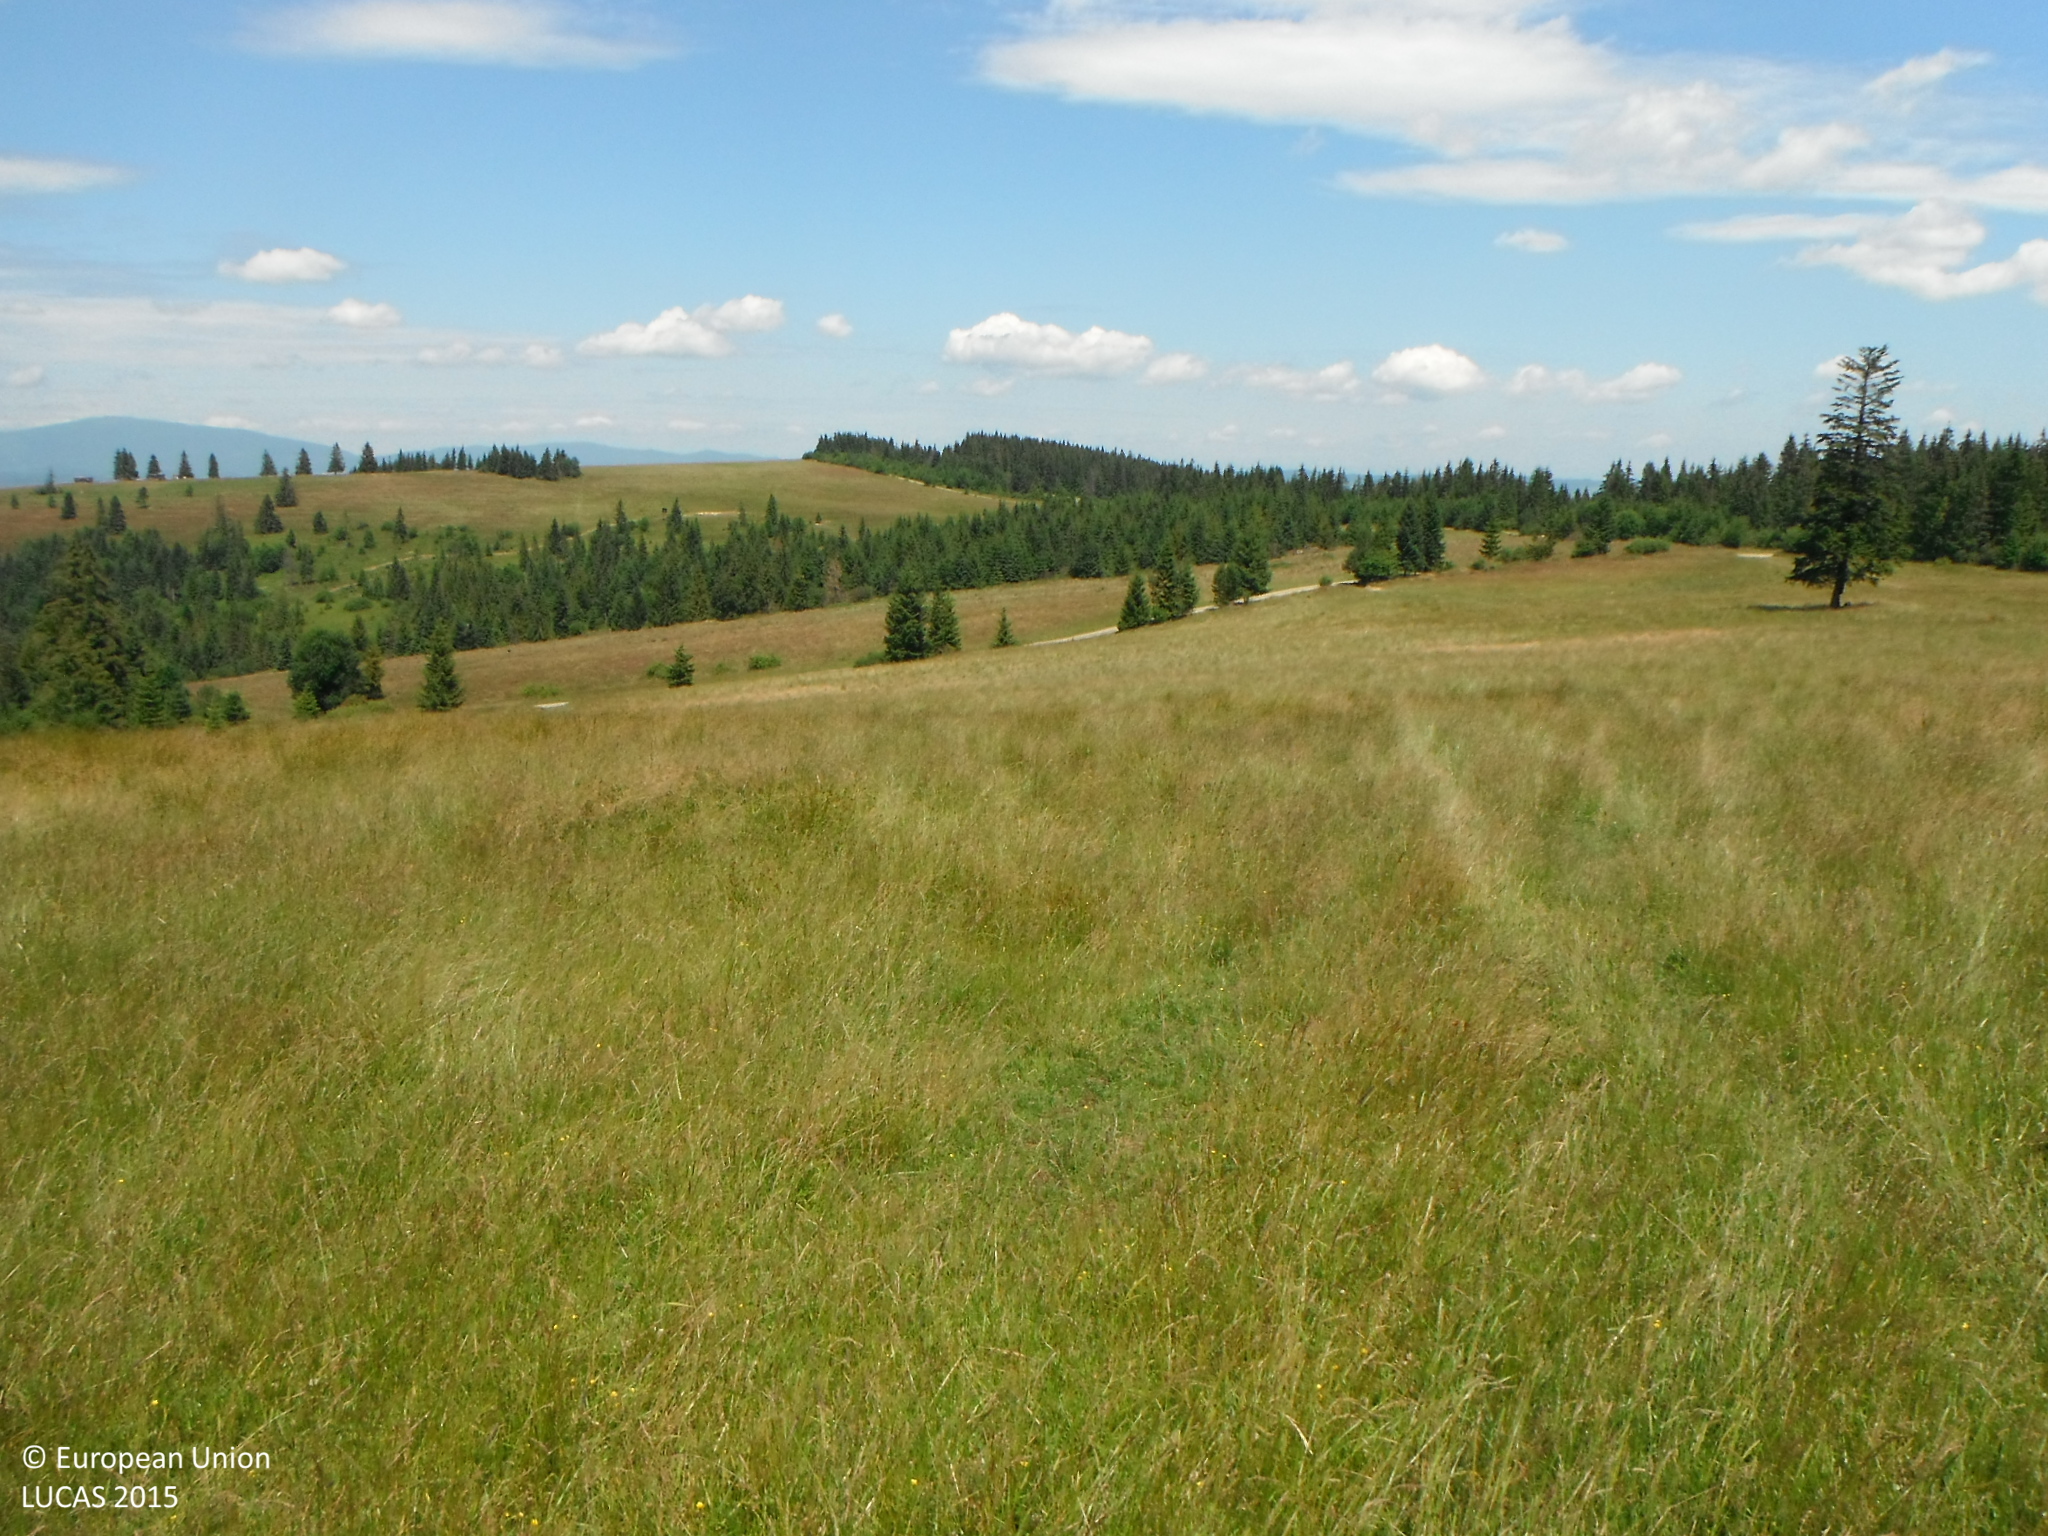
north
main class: Grassland
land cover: Grassland without tree/shrub cover
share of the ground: > 75 %
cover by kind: herbaceous plants 100 %
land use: Agriculture (excluding fallow land and kitchen gardens)
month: July
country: SK
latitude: 49.3300
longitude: 19.7573
